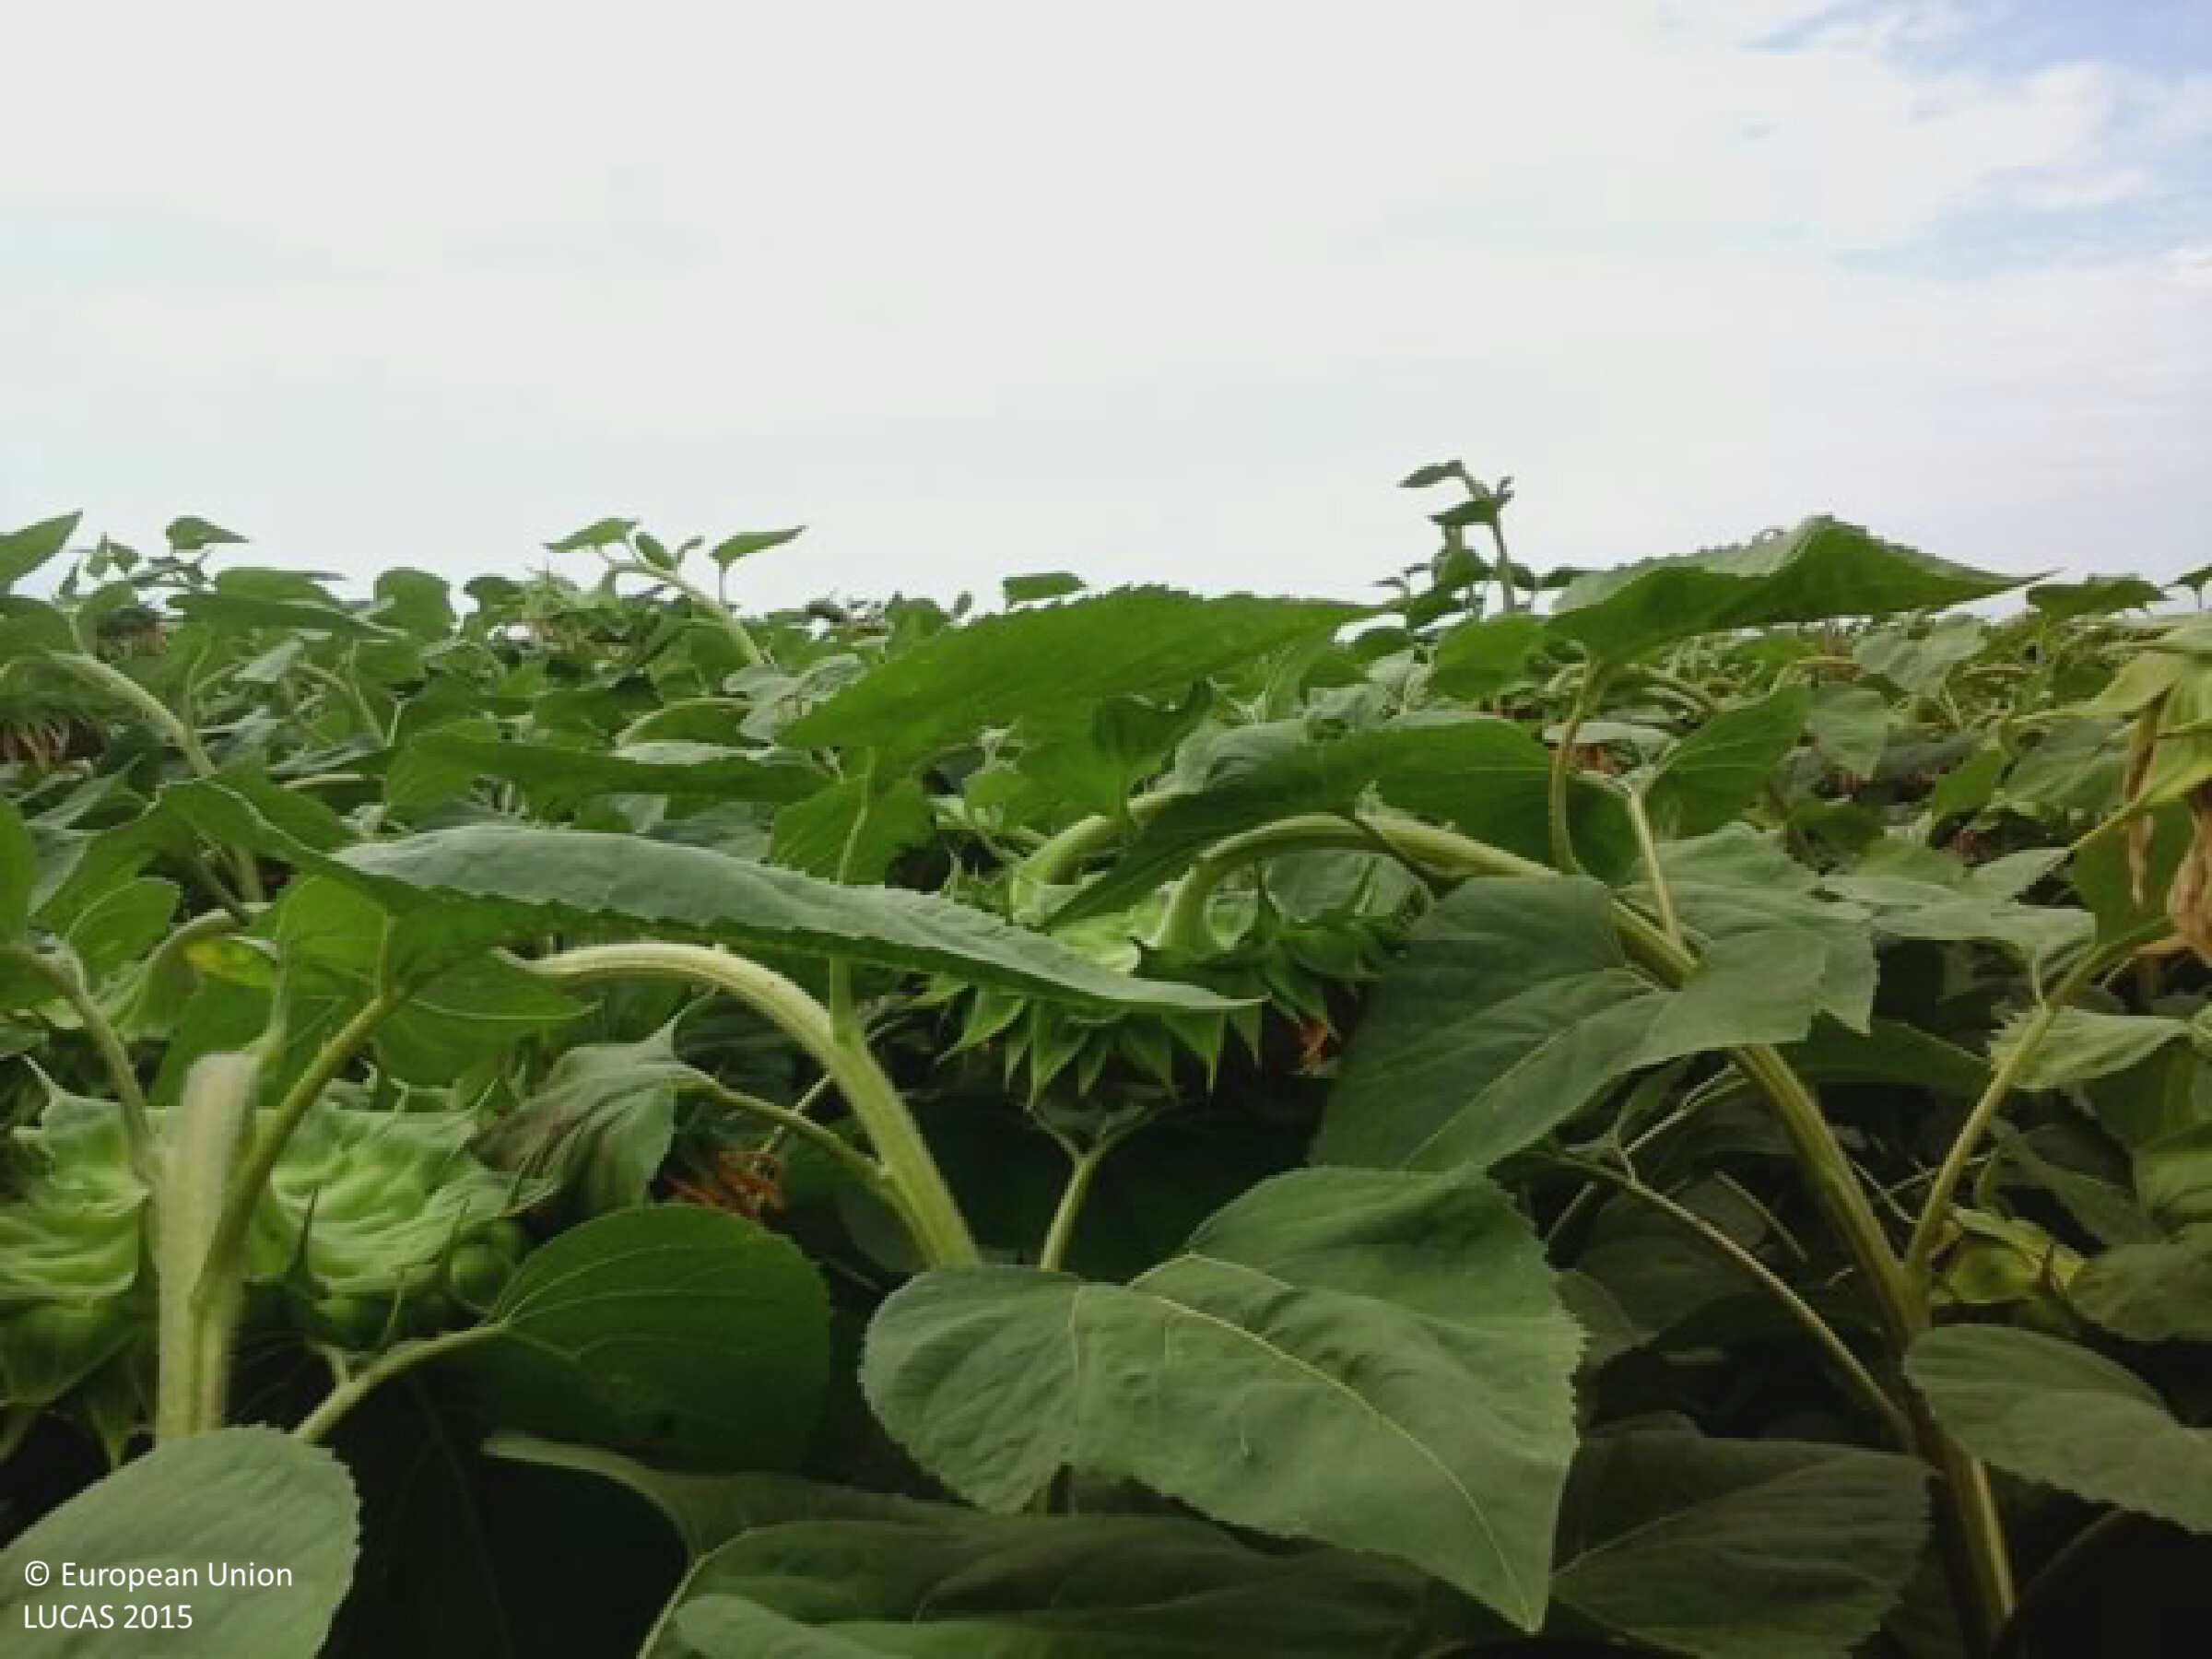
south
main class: Cropland
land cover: Sunflower
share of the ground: > 75 %
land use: Agriculture (excluding fallow land and kitchen gardens)
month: July
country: HU
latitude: 46.0041
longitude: 19.0384
